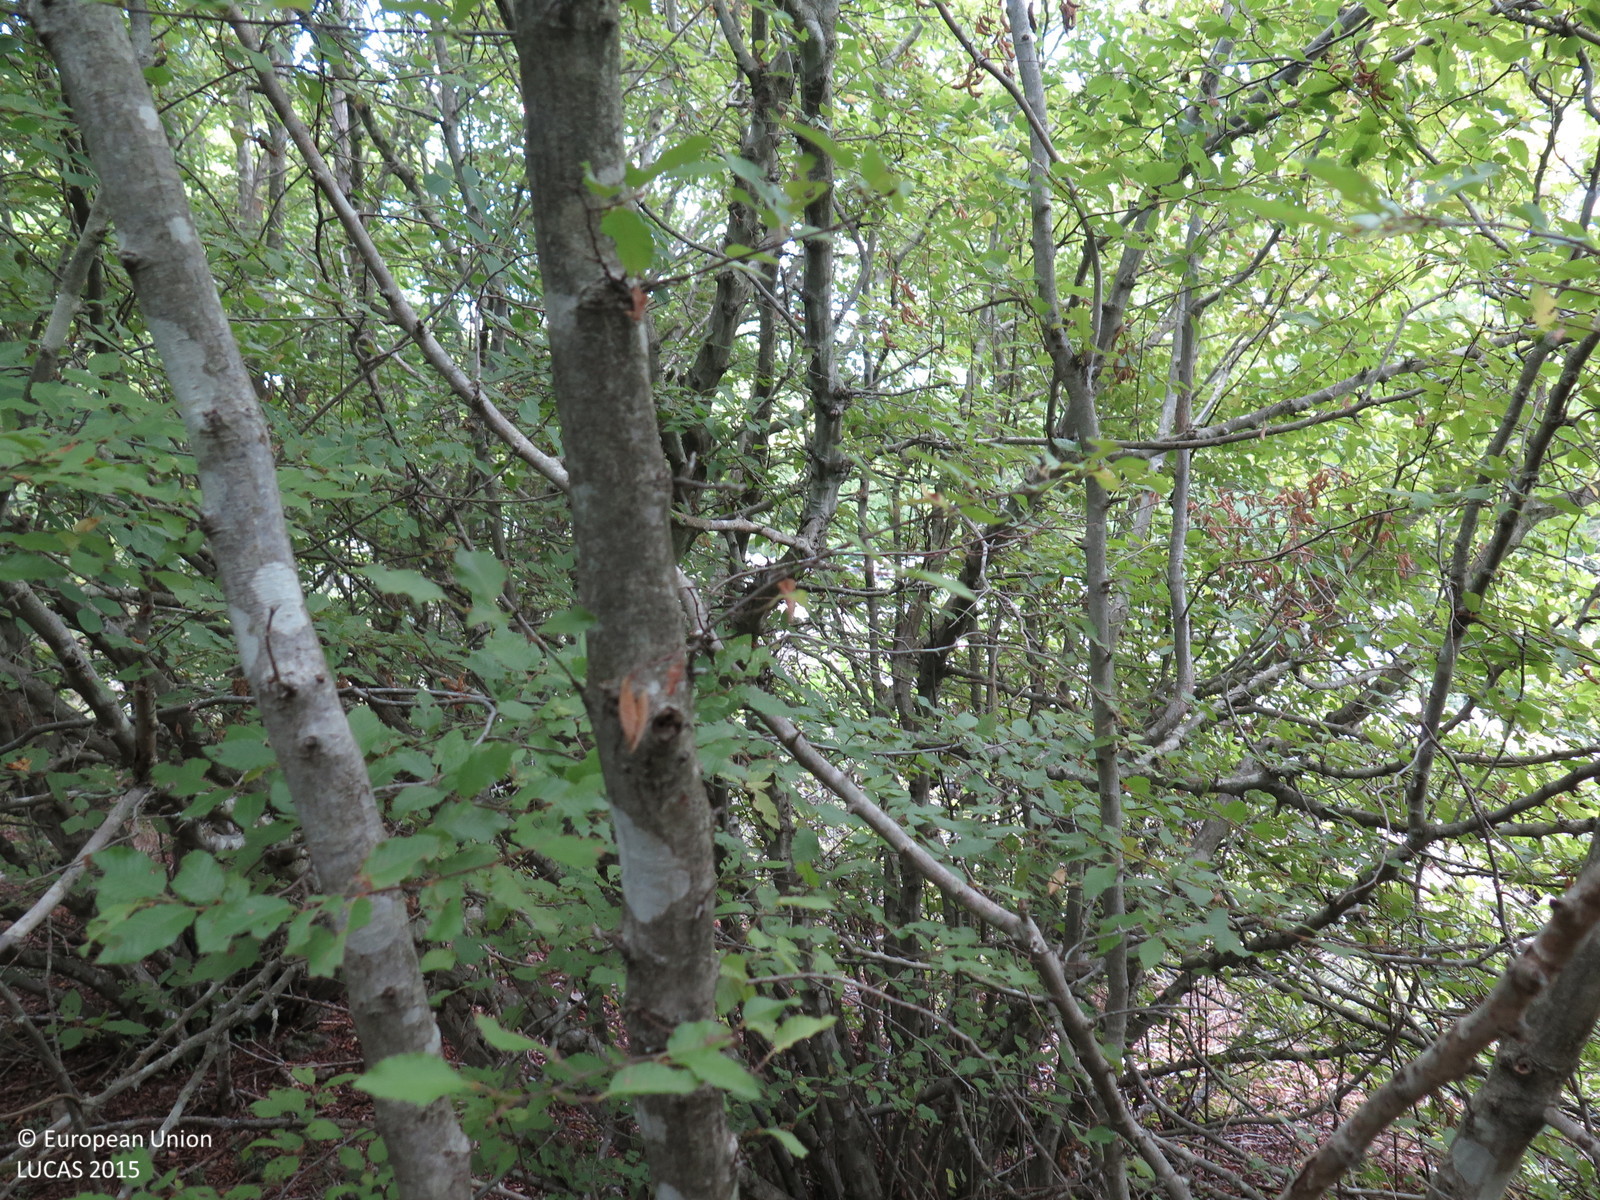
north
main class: Woodland
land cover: Broadleaved woodland
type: thermophilous deciduous forest
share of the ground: > 75 %
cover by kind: broadleaved forest trees 90 %, shrubs 5 %, herbaceous plants 5 %
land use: Semi-natural and natural areas not in use
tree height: < 5 m
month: August
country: HR
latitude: 45.0654
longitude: 14.5030
